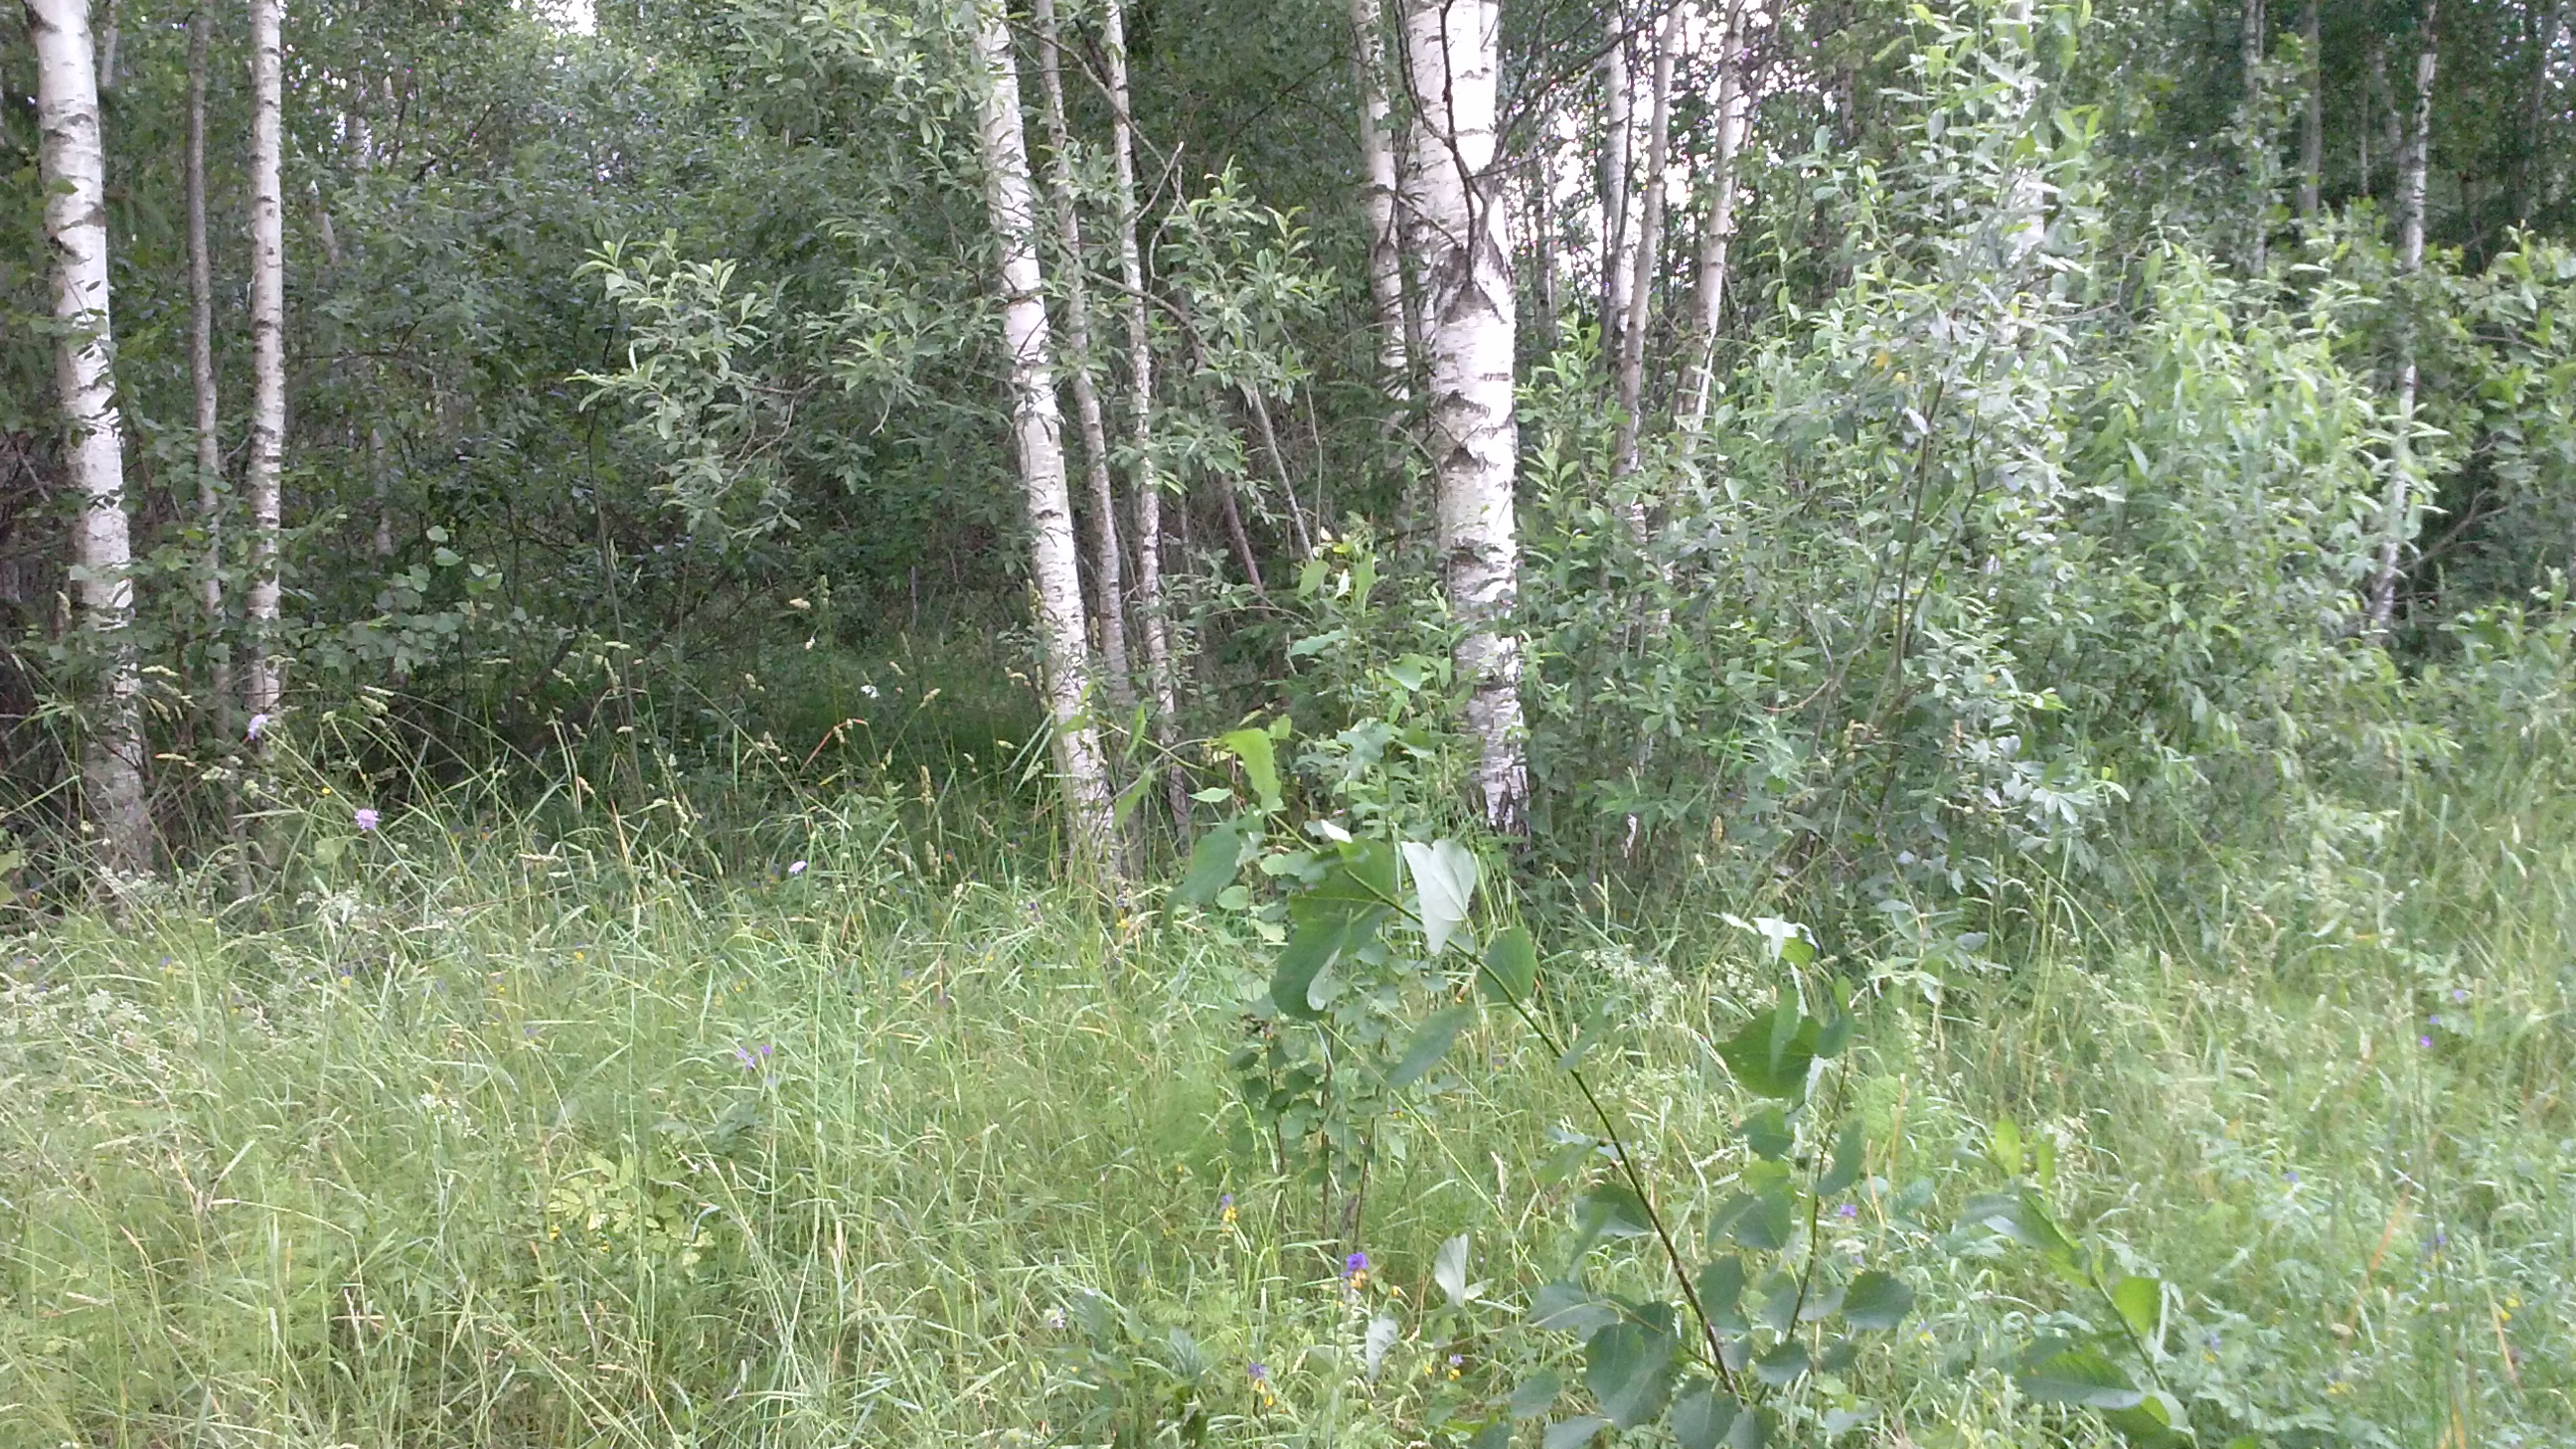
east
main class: Woodland
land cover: Broadleaved woodland
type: non-riverine alder, birch or aspen forest
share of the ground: 50 - 75 %
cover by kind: broadleaved forest trees 65 %, herbaceous plants 30 %, coniferous forest trees 5 %
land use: Forestry
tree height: > 5 m
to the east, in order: Broadleaved woodland; Grassland with sparse tree/shrub cover; Spontaneously vegetated surfaces; Broadleaved woodland; Spruce dominated mixed woodland
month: July
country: LV
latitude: 56.5614
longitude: 27.4749
